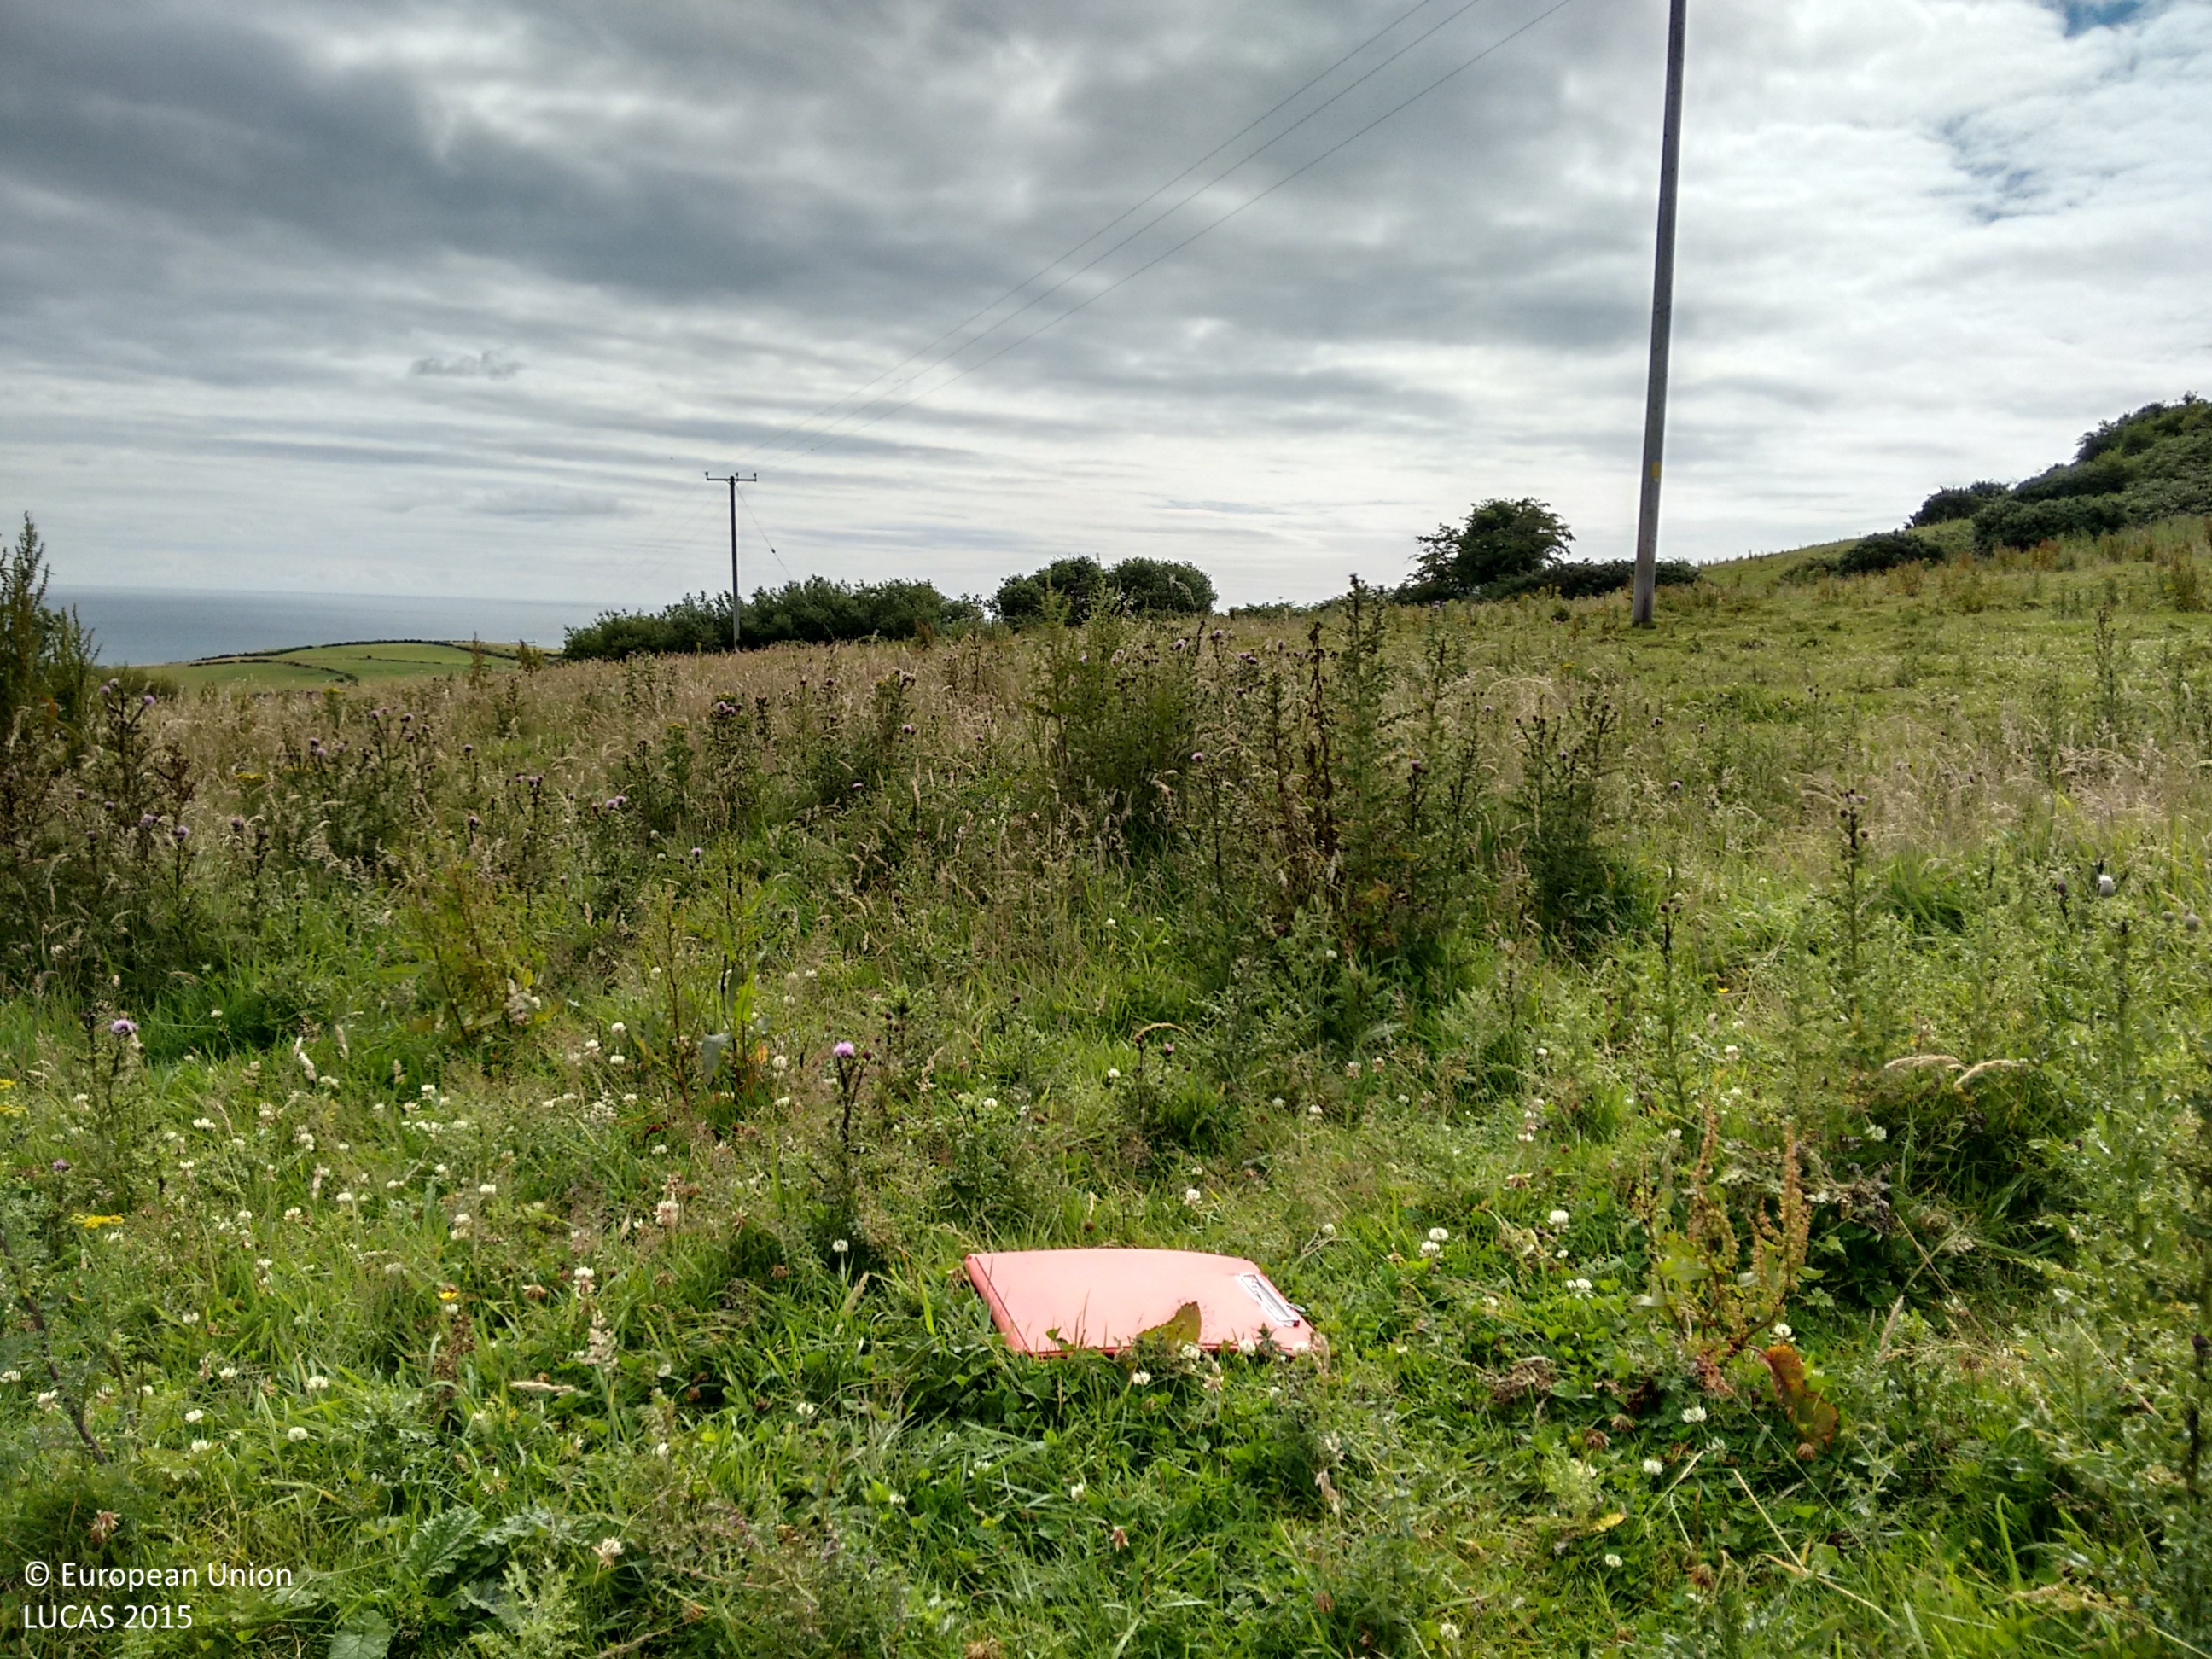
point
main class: Grassland
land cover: Grassland without tree/shrub cover
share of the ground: > 75 %
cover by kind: herbaceous plants 100 %
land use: Agriculture (excluding fallow land and kitchen gardens)
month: July
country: IE
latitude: 52.9662
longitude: -6.0302
